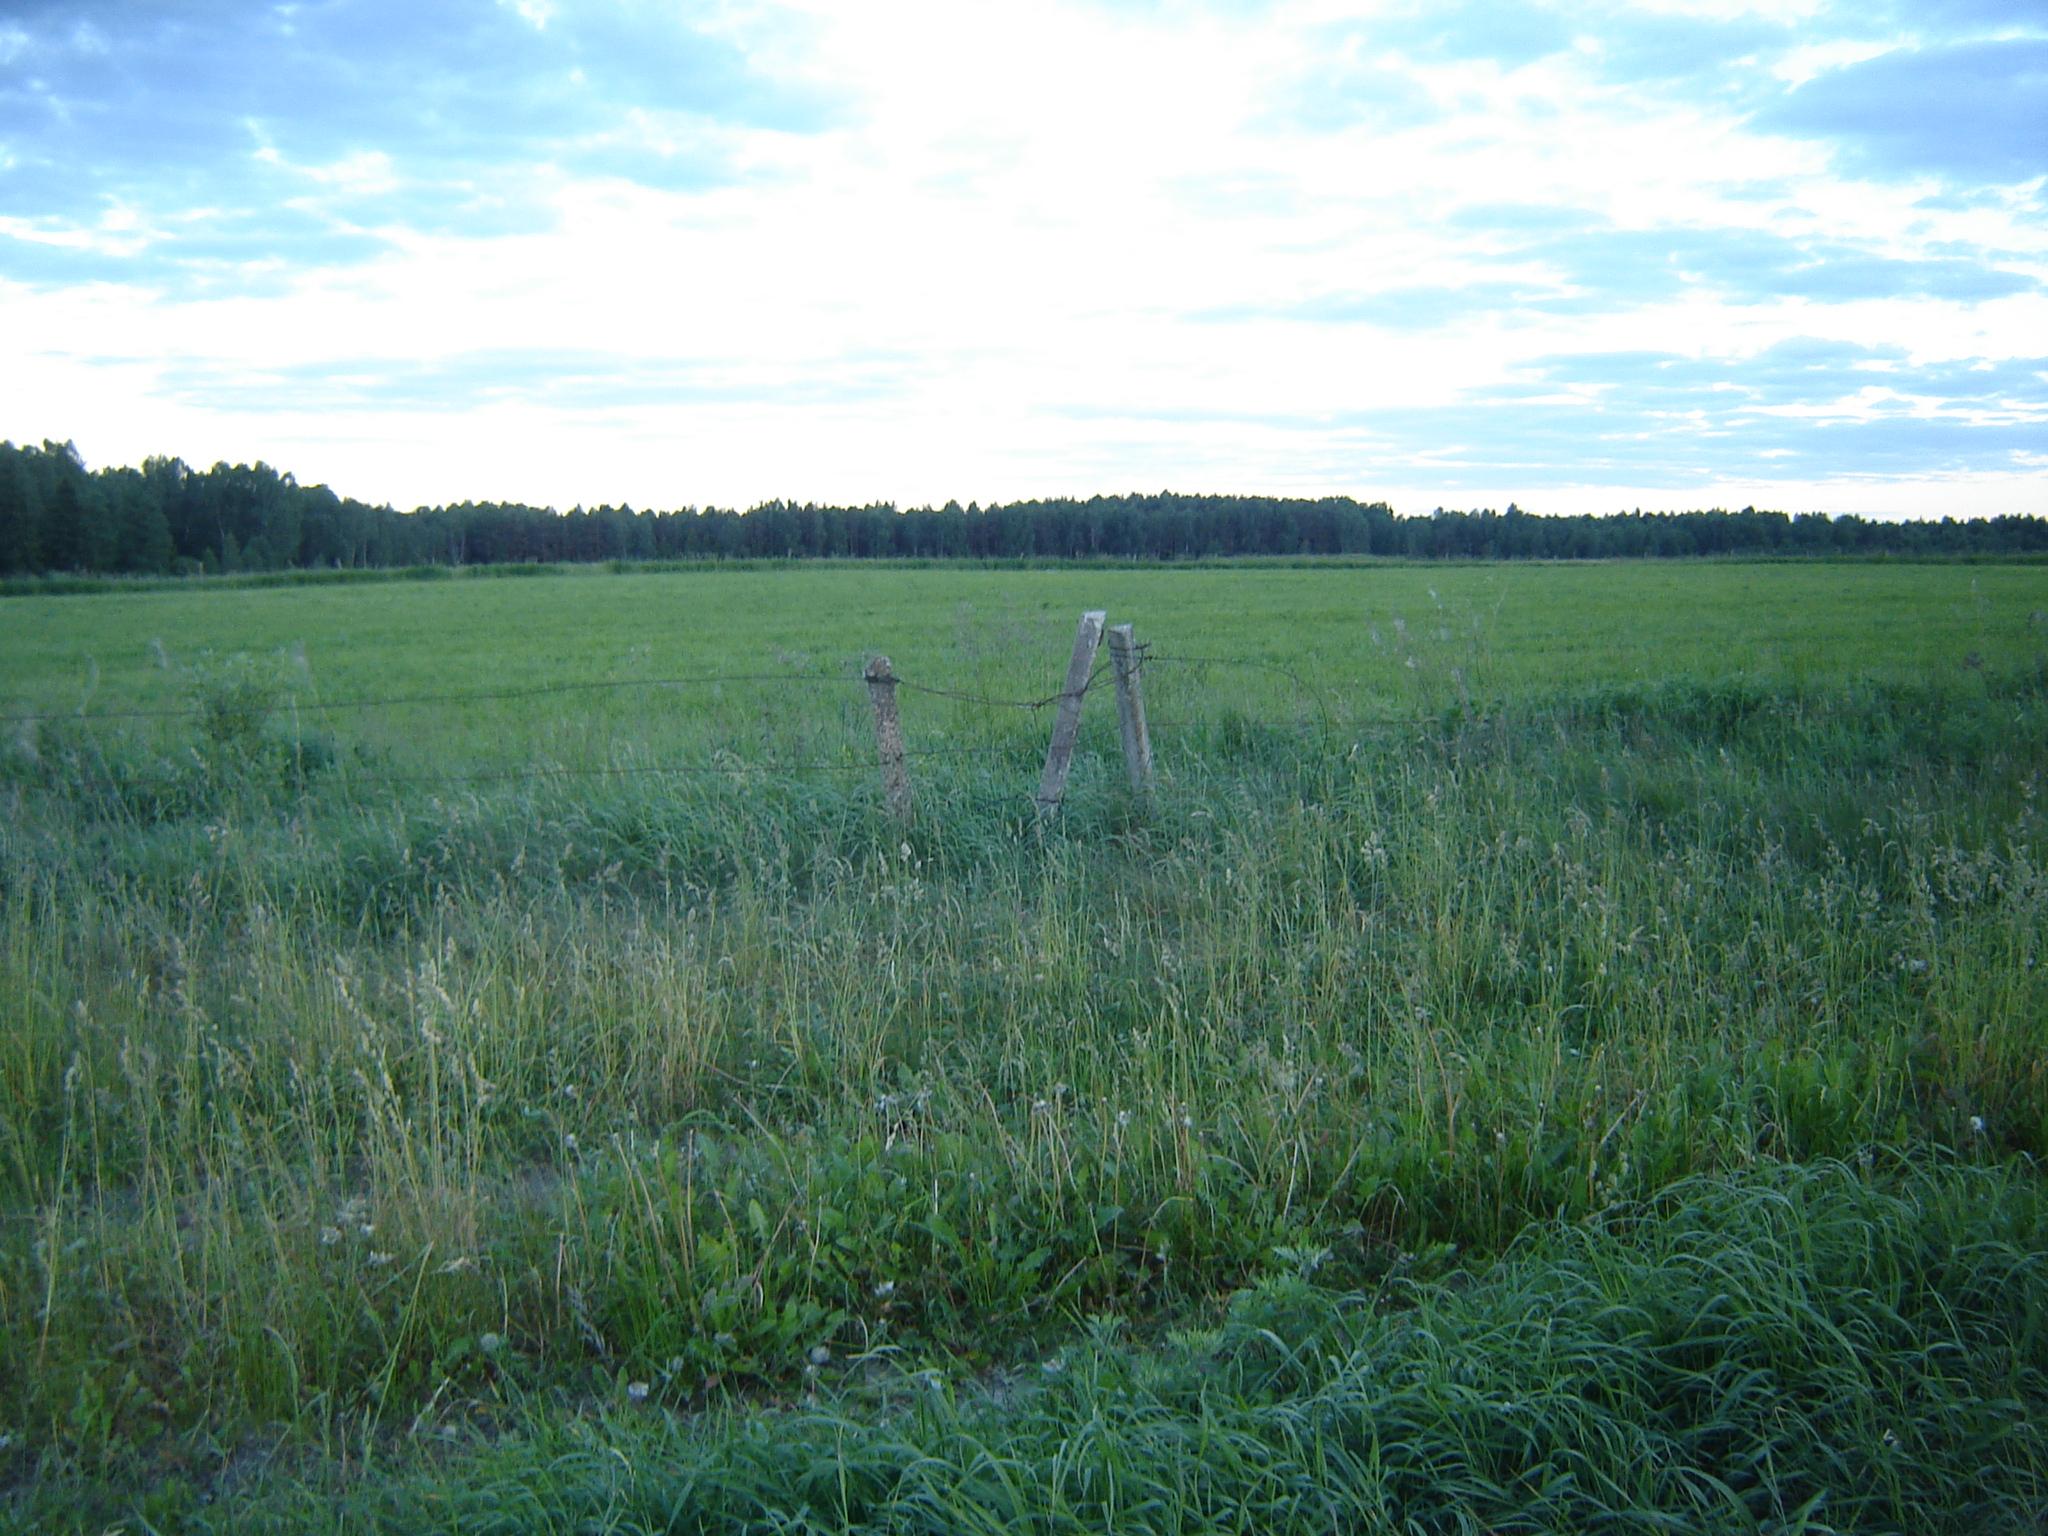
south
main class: Cropland
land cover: Maize
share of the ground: < 10 %
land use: Agriculture (excluding fallow land and kitchen gardens)
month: June
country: LT
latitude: 55.5712
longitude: 24.7112
